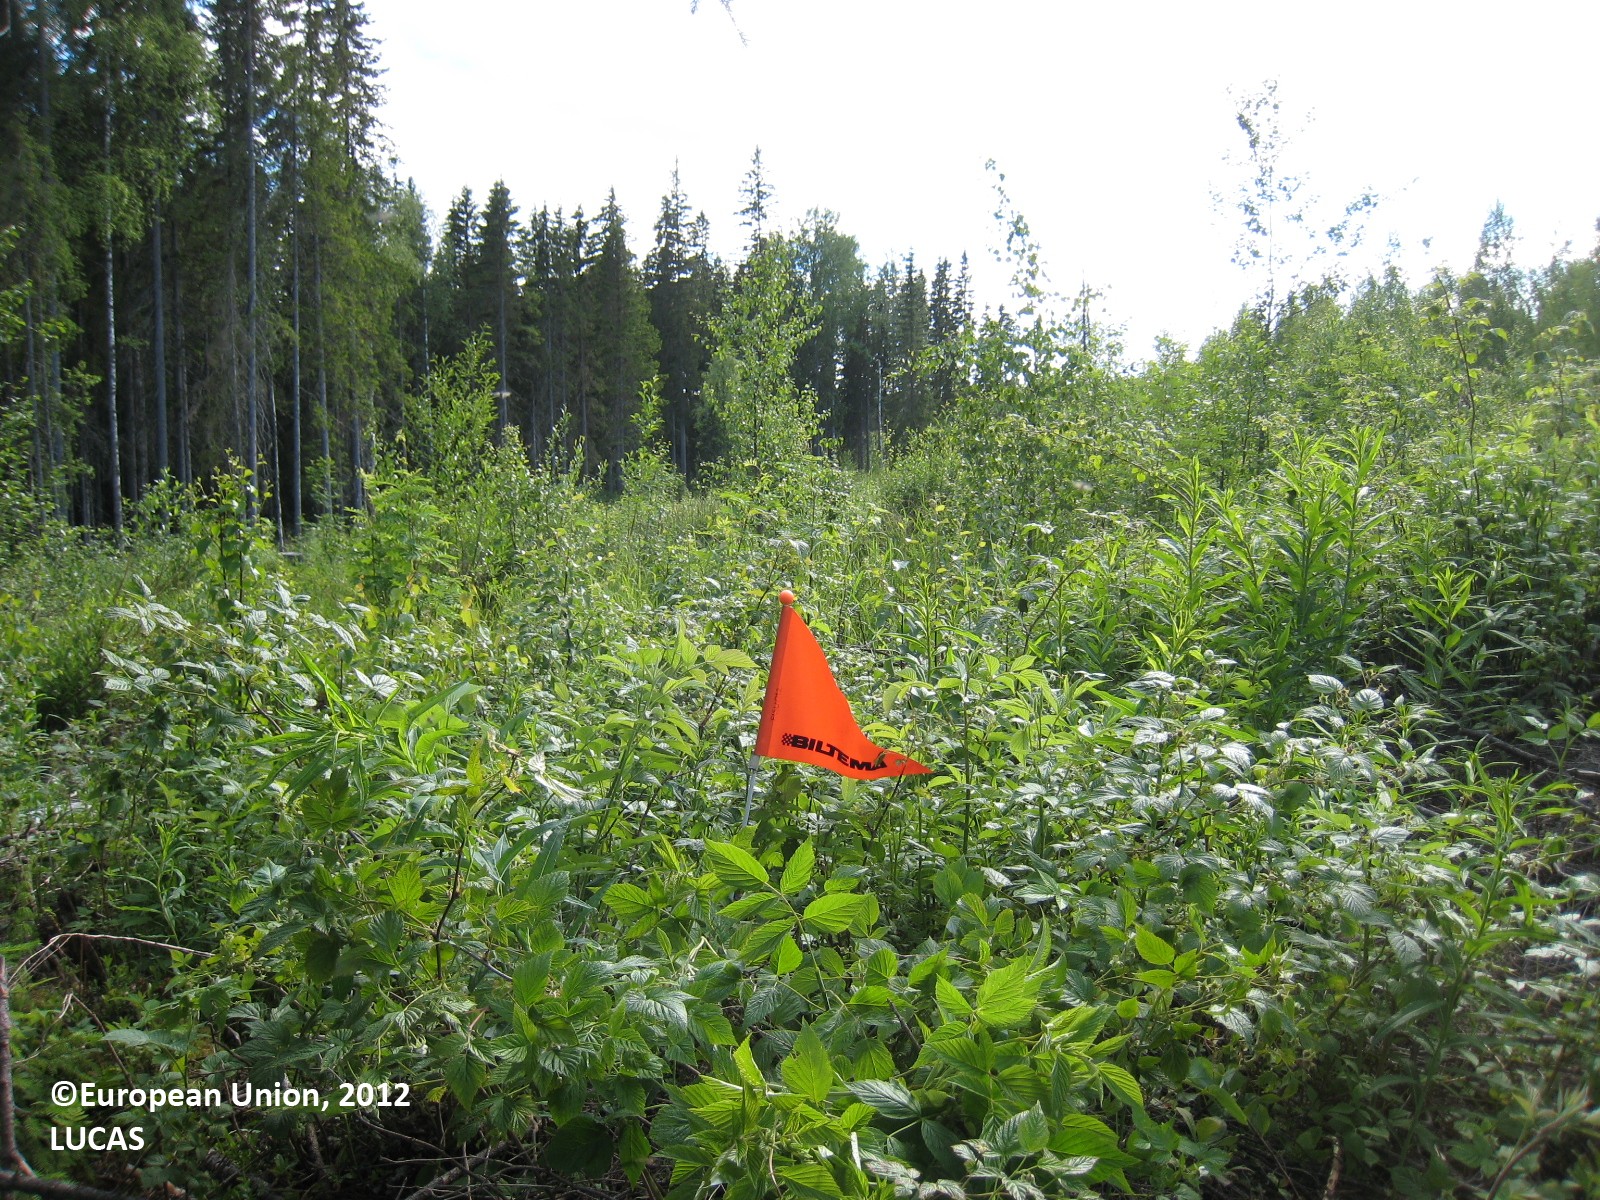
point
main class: Woodland
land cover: Broadleaved woodland
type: boreal forest
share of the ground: 25 - 50 %
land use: Forestry
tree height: < 5 m
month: June
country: FI
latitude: 62.4840
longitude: 26.5335
